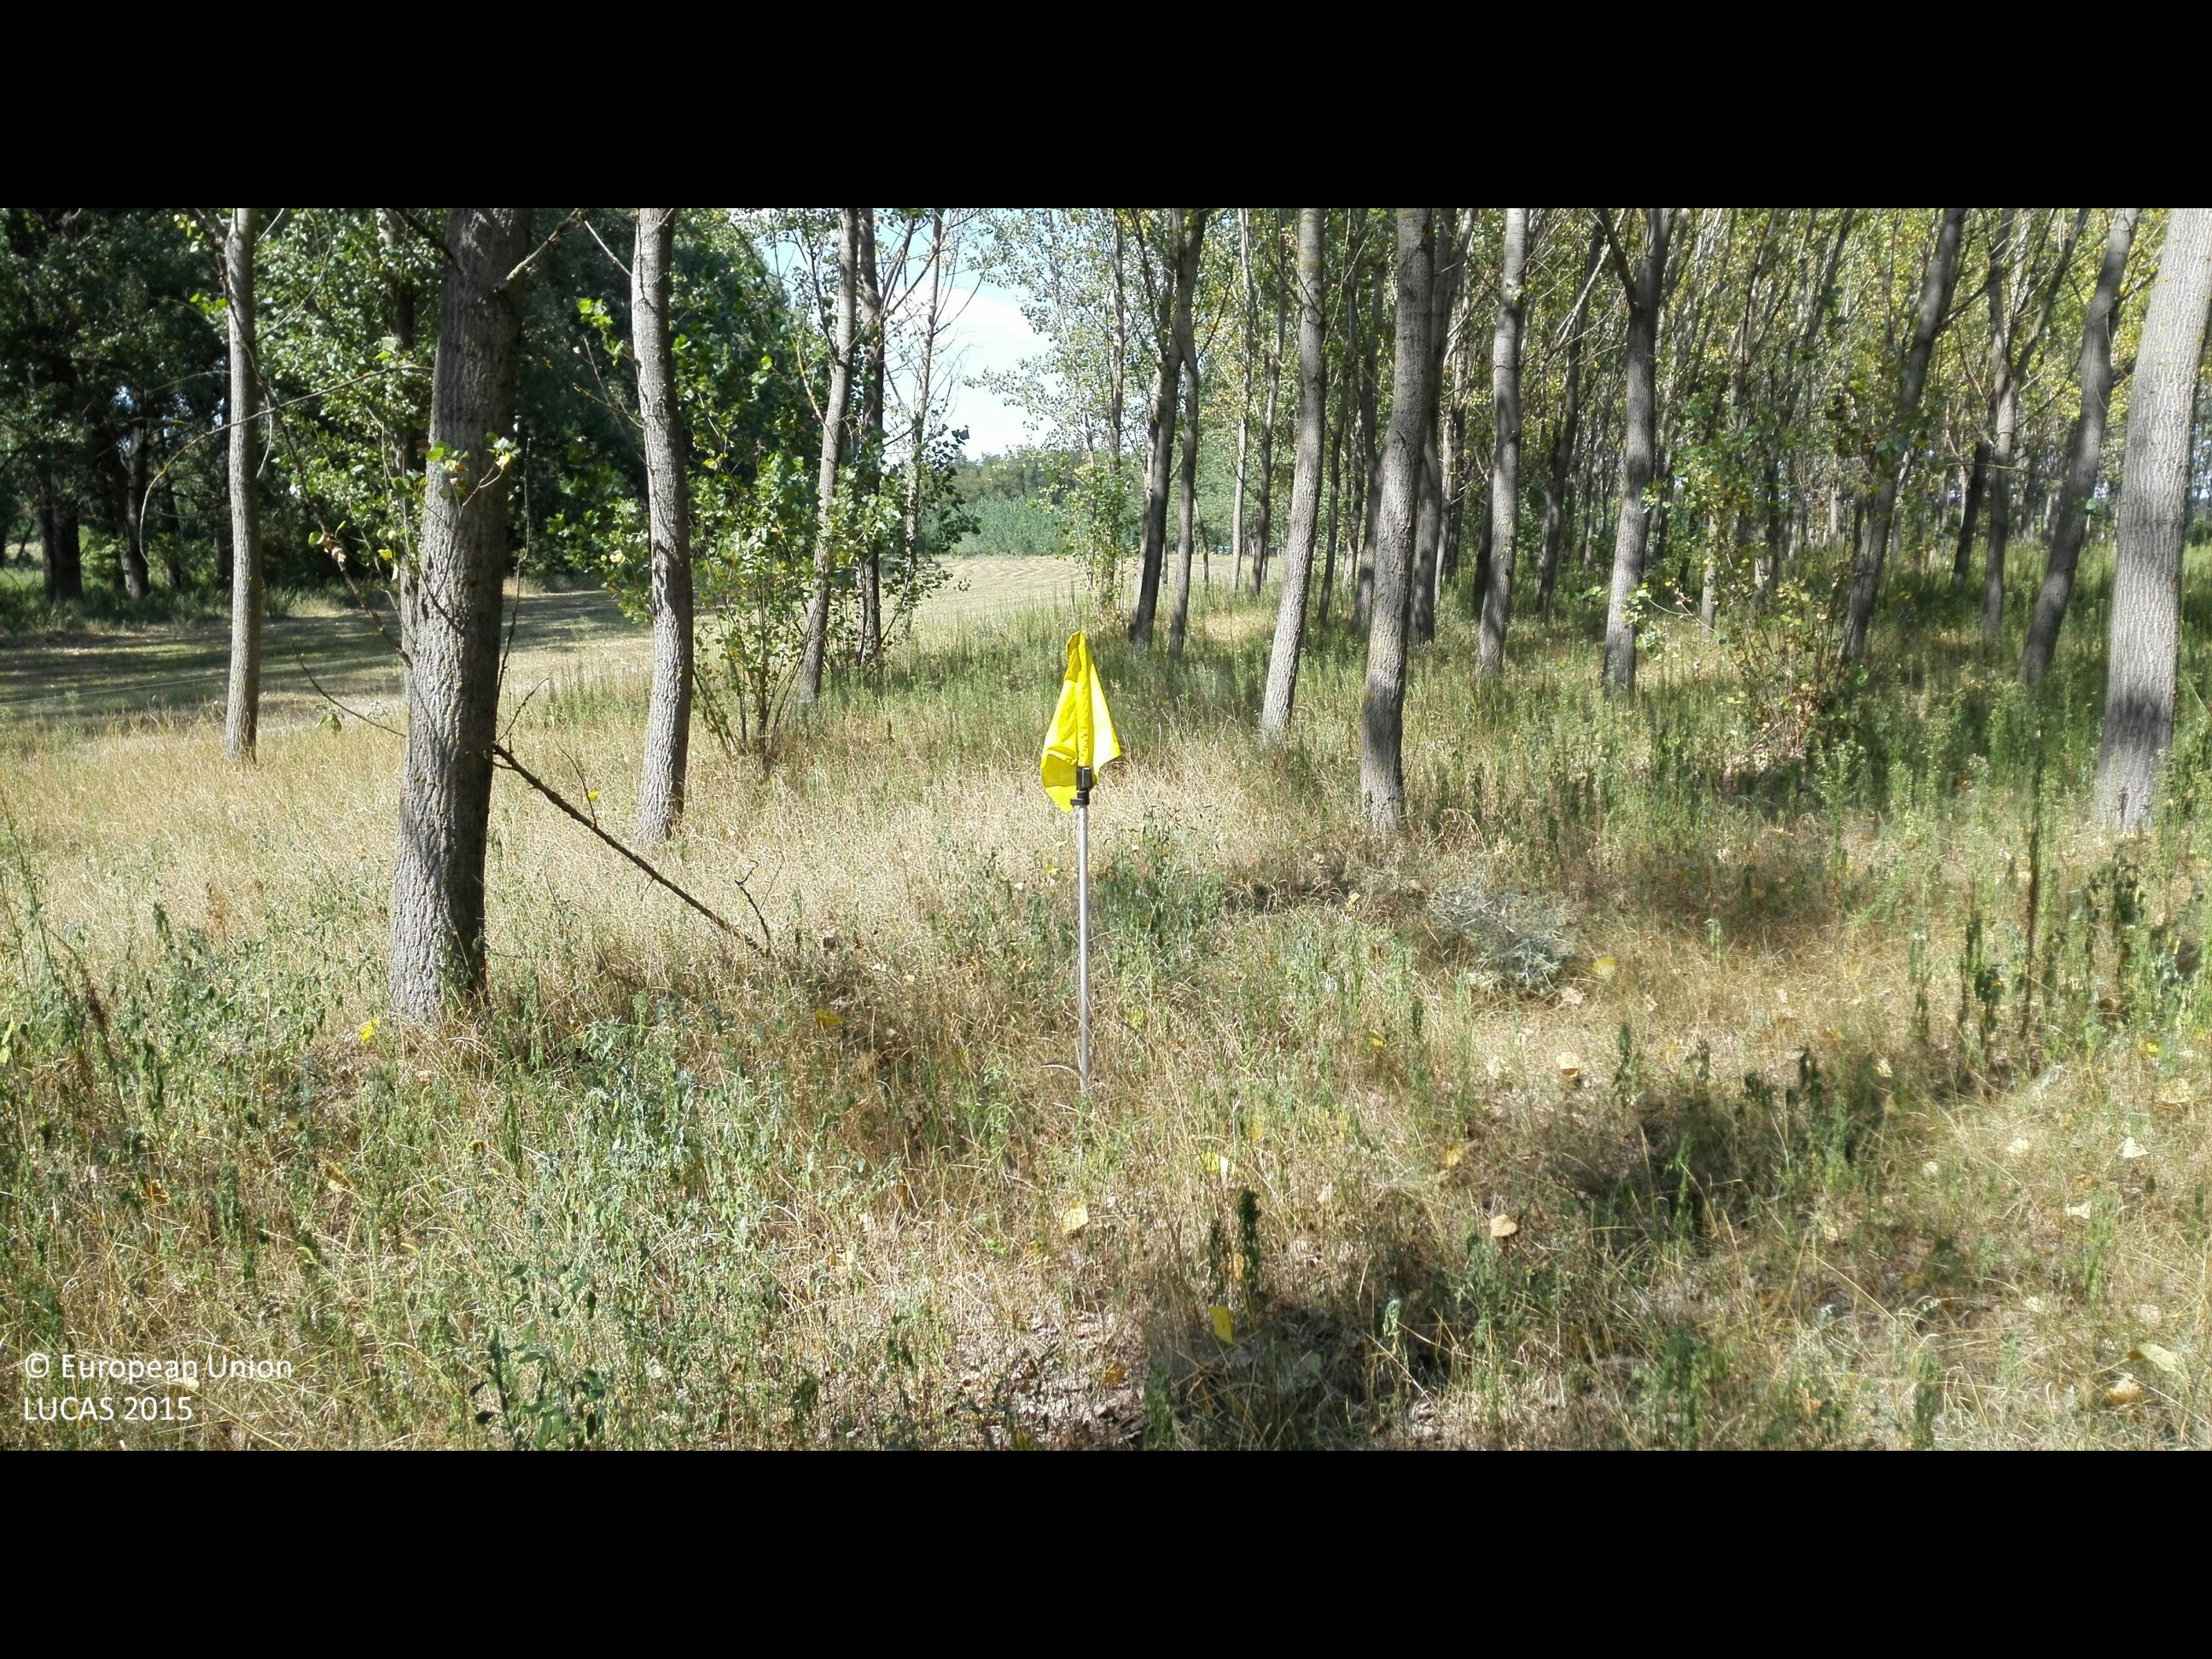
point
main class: Woodland
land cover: Broadleaved woodland
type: non-riverine alder, birch or aspen forest
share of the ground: > 75 %
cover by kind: broadleaved forest trees 90 %, herbaceous plants 10 %
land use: Forestry
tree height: > 5 m
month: August
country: HU
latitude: 47.3939
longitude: 21.9052
